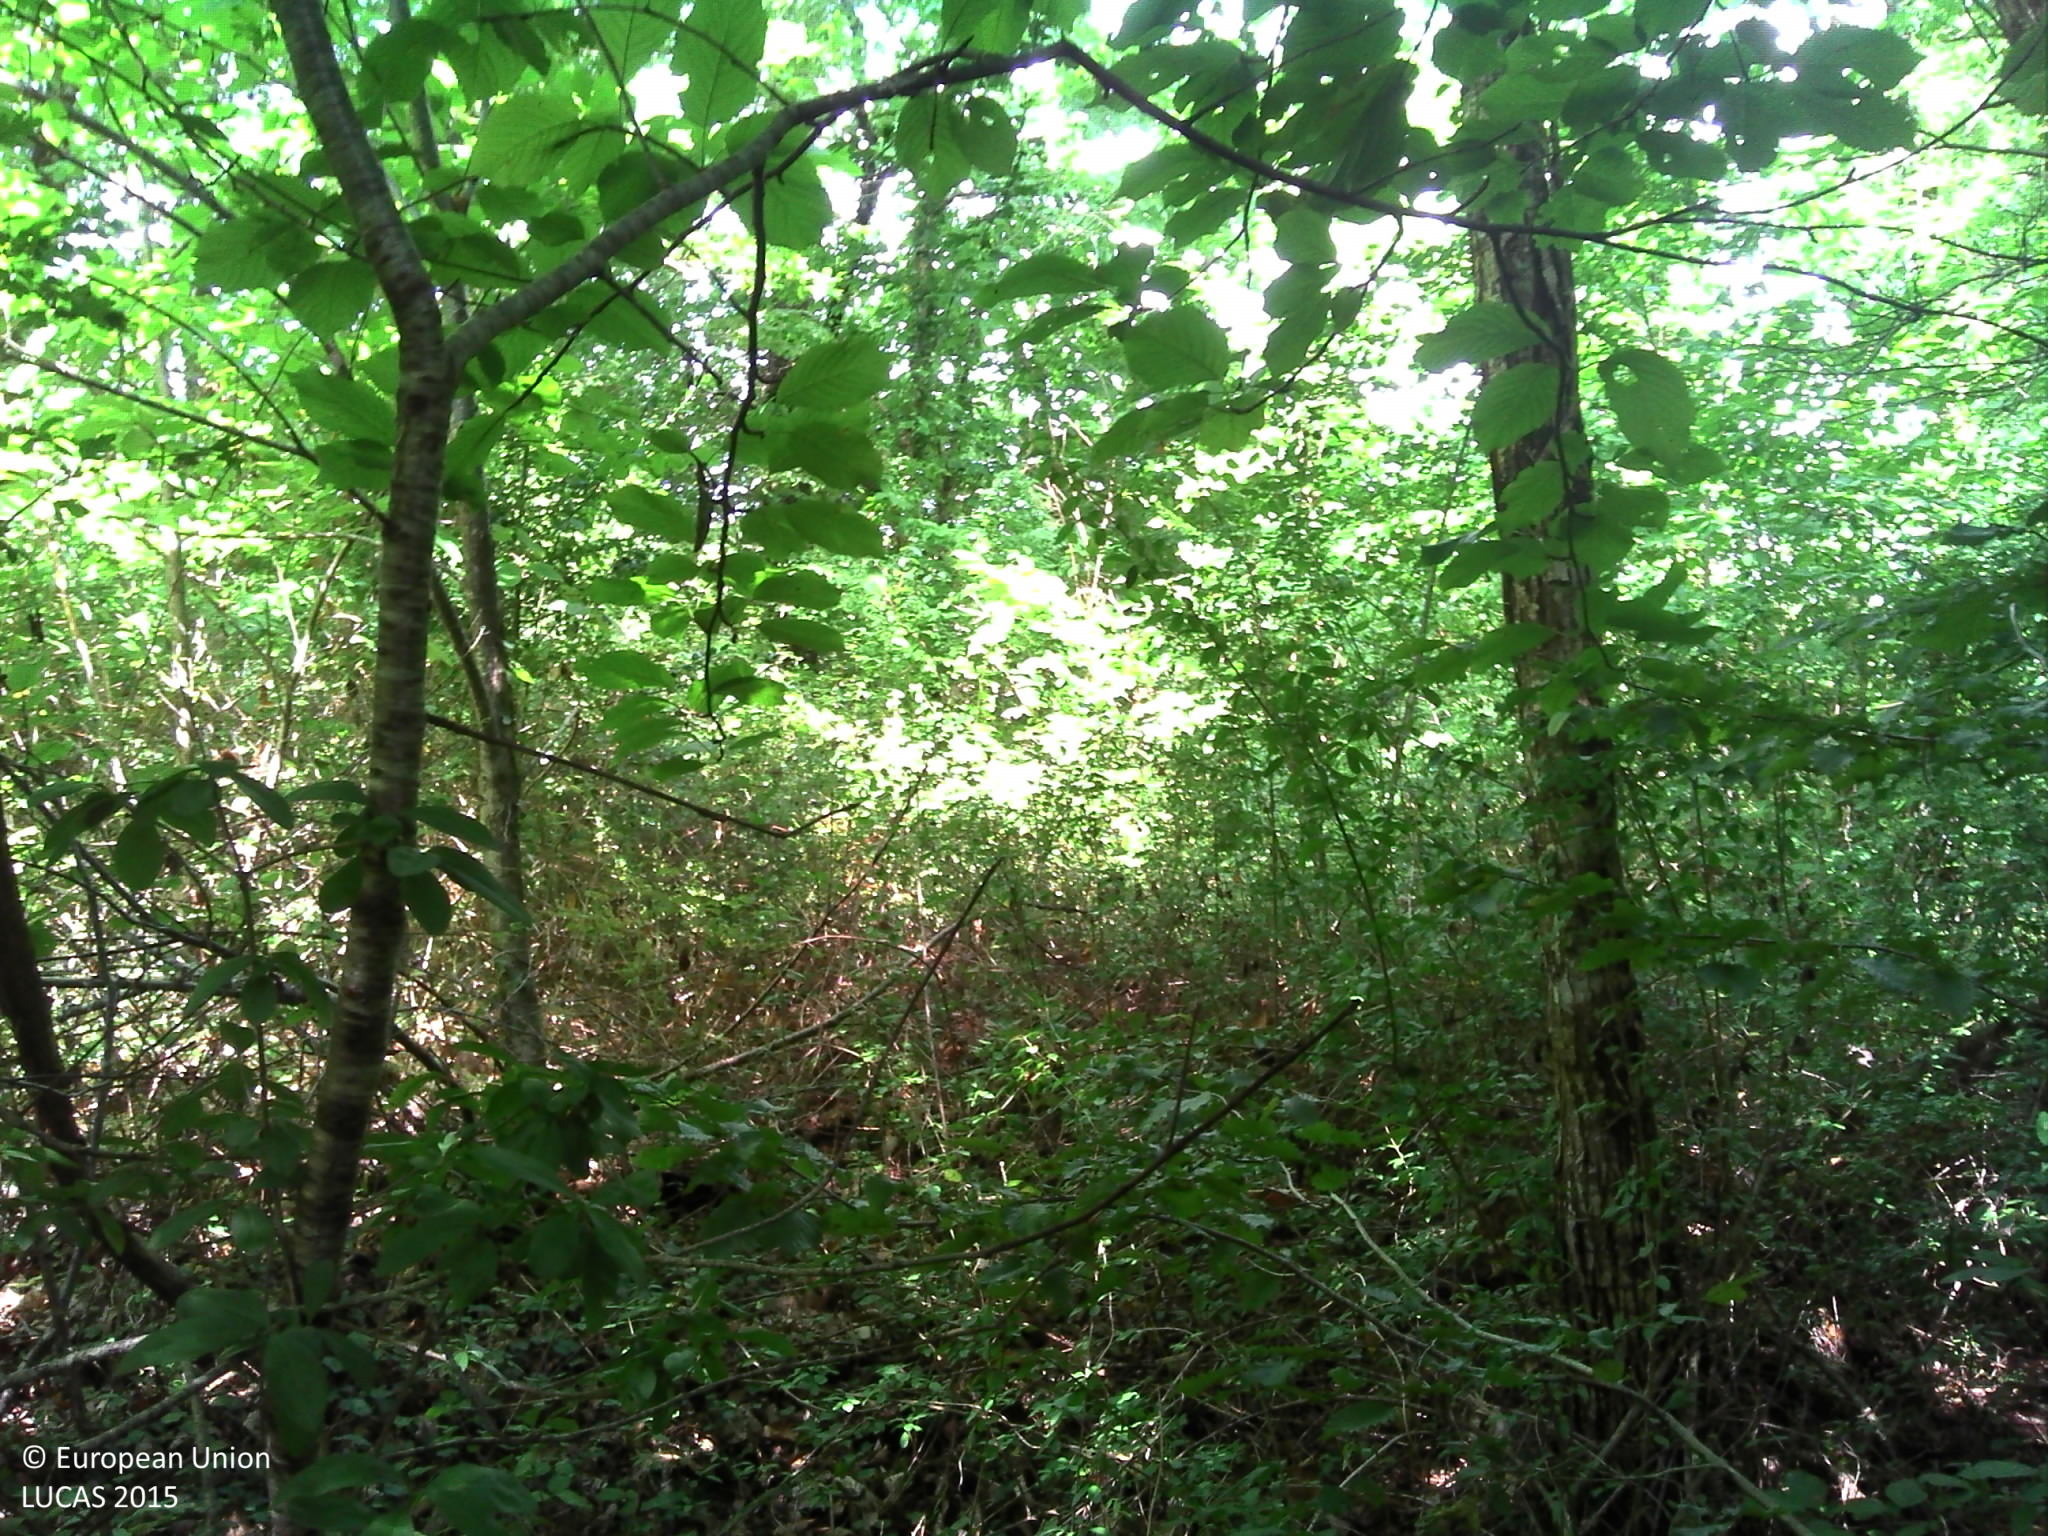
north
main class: Woodland
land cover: Broadleaved woodland
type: thermophilous deciduous forest
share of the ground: > 75 %
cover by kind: broadleaved forest trees 70 %, shrubs 20 %, herbaceous plants 5 %, lichens and mosses 5 %
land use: Forestry
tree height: > 5 m
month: August
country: FR
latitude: 45.3632
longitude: 0.4763
